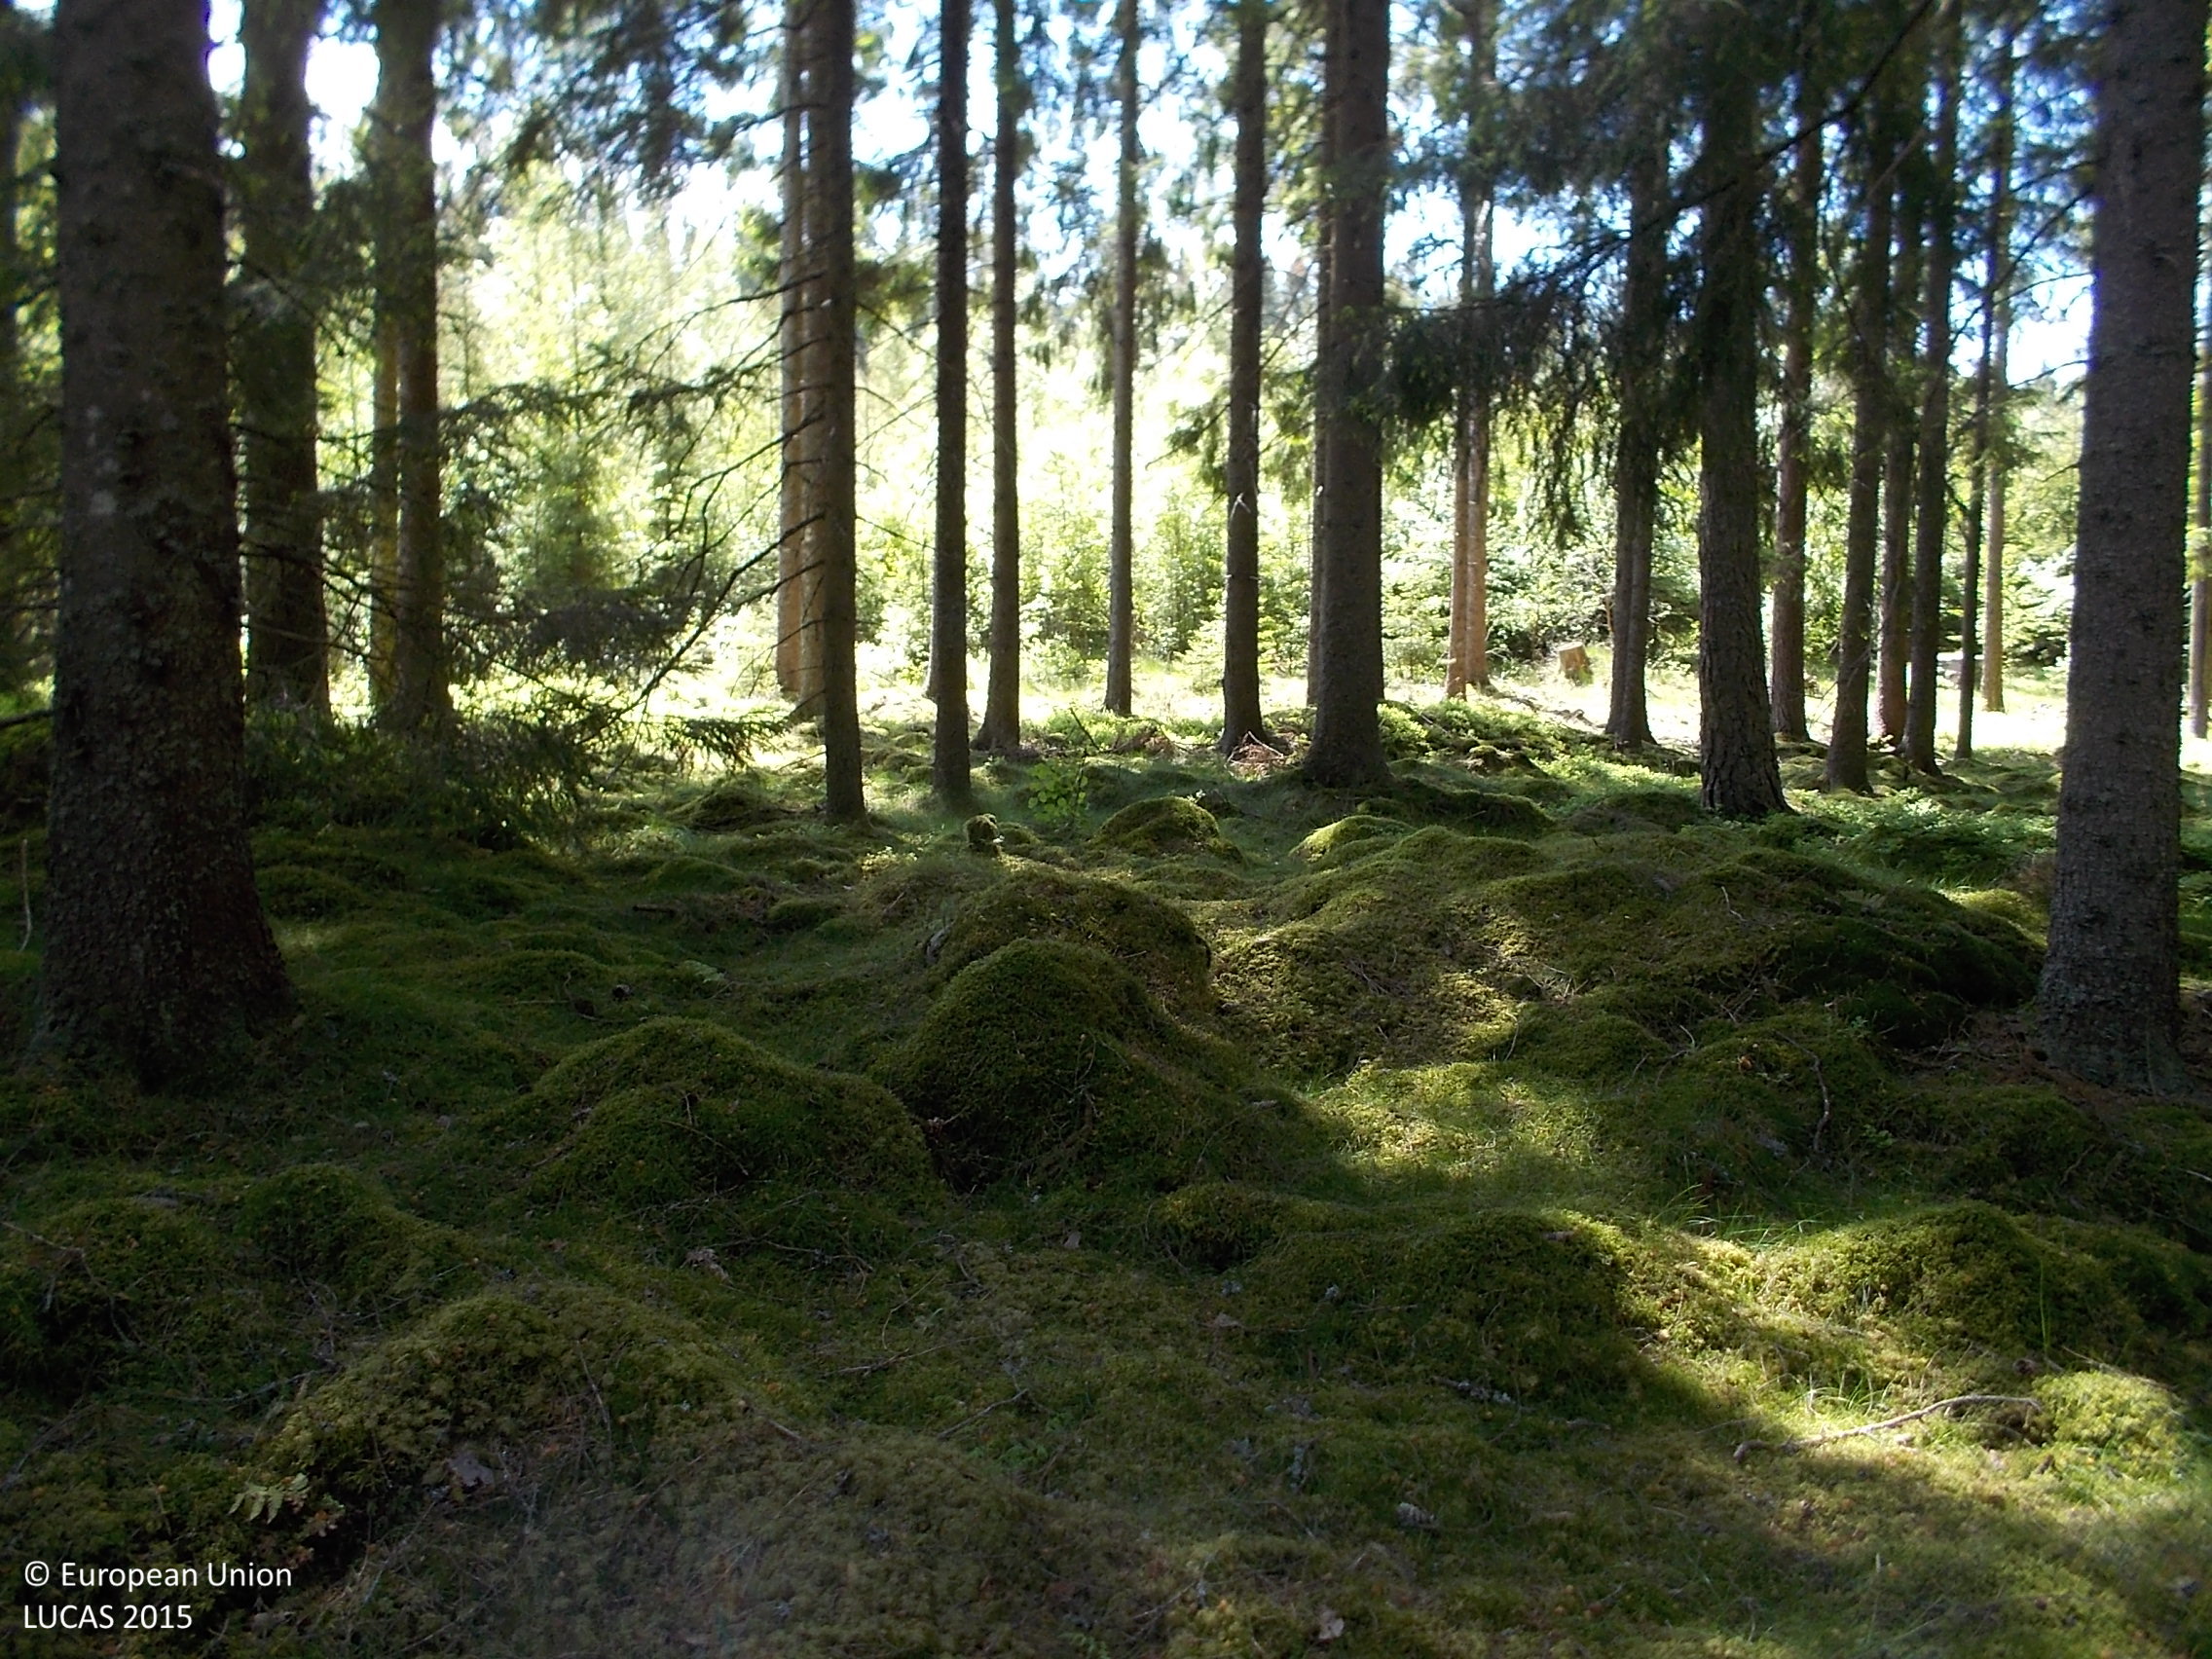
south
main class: Woodland
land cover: Spruce dominated coniferous woodland
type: boreal forest
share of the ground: > 75 %
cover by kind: coniferous forest trees 85 %, shrubs 5 %, herbaceous plants 5 %, lichens and mosses 5 %
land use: Forestry
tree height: > 5 m
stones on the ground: < 10 %
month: June
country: SE
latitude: 57.7485
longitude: 13.2380
